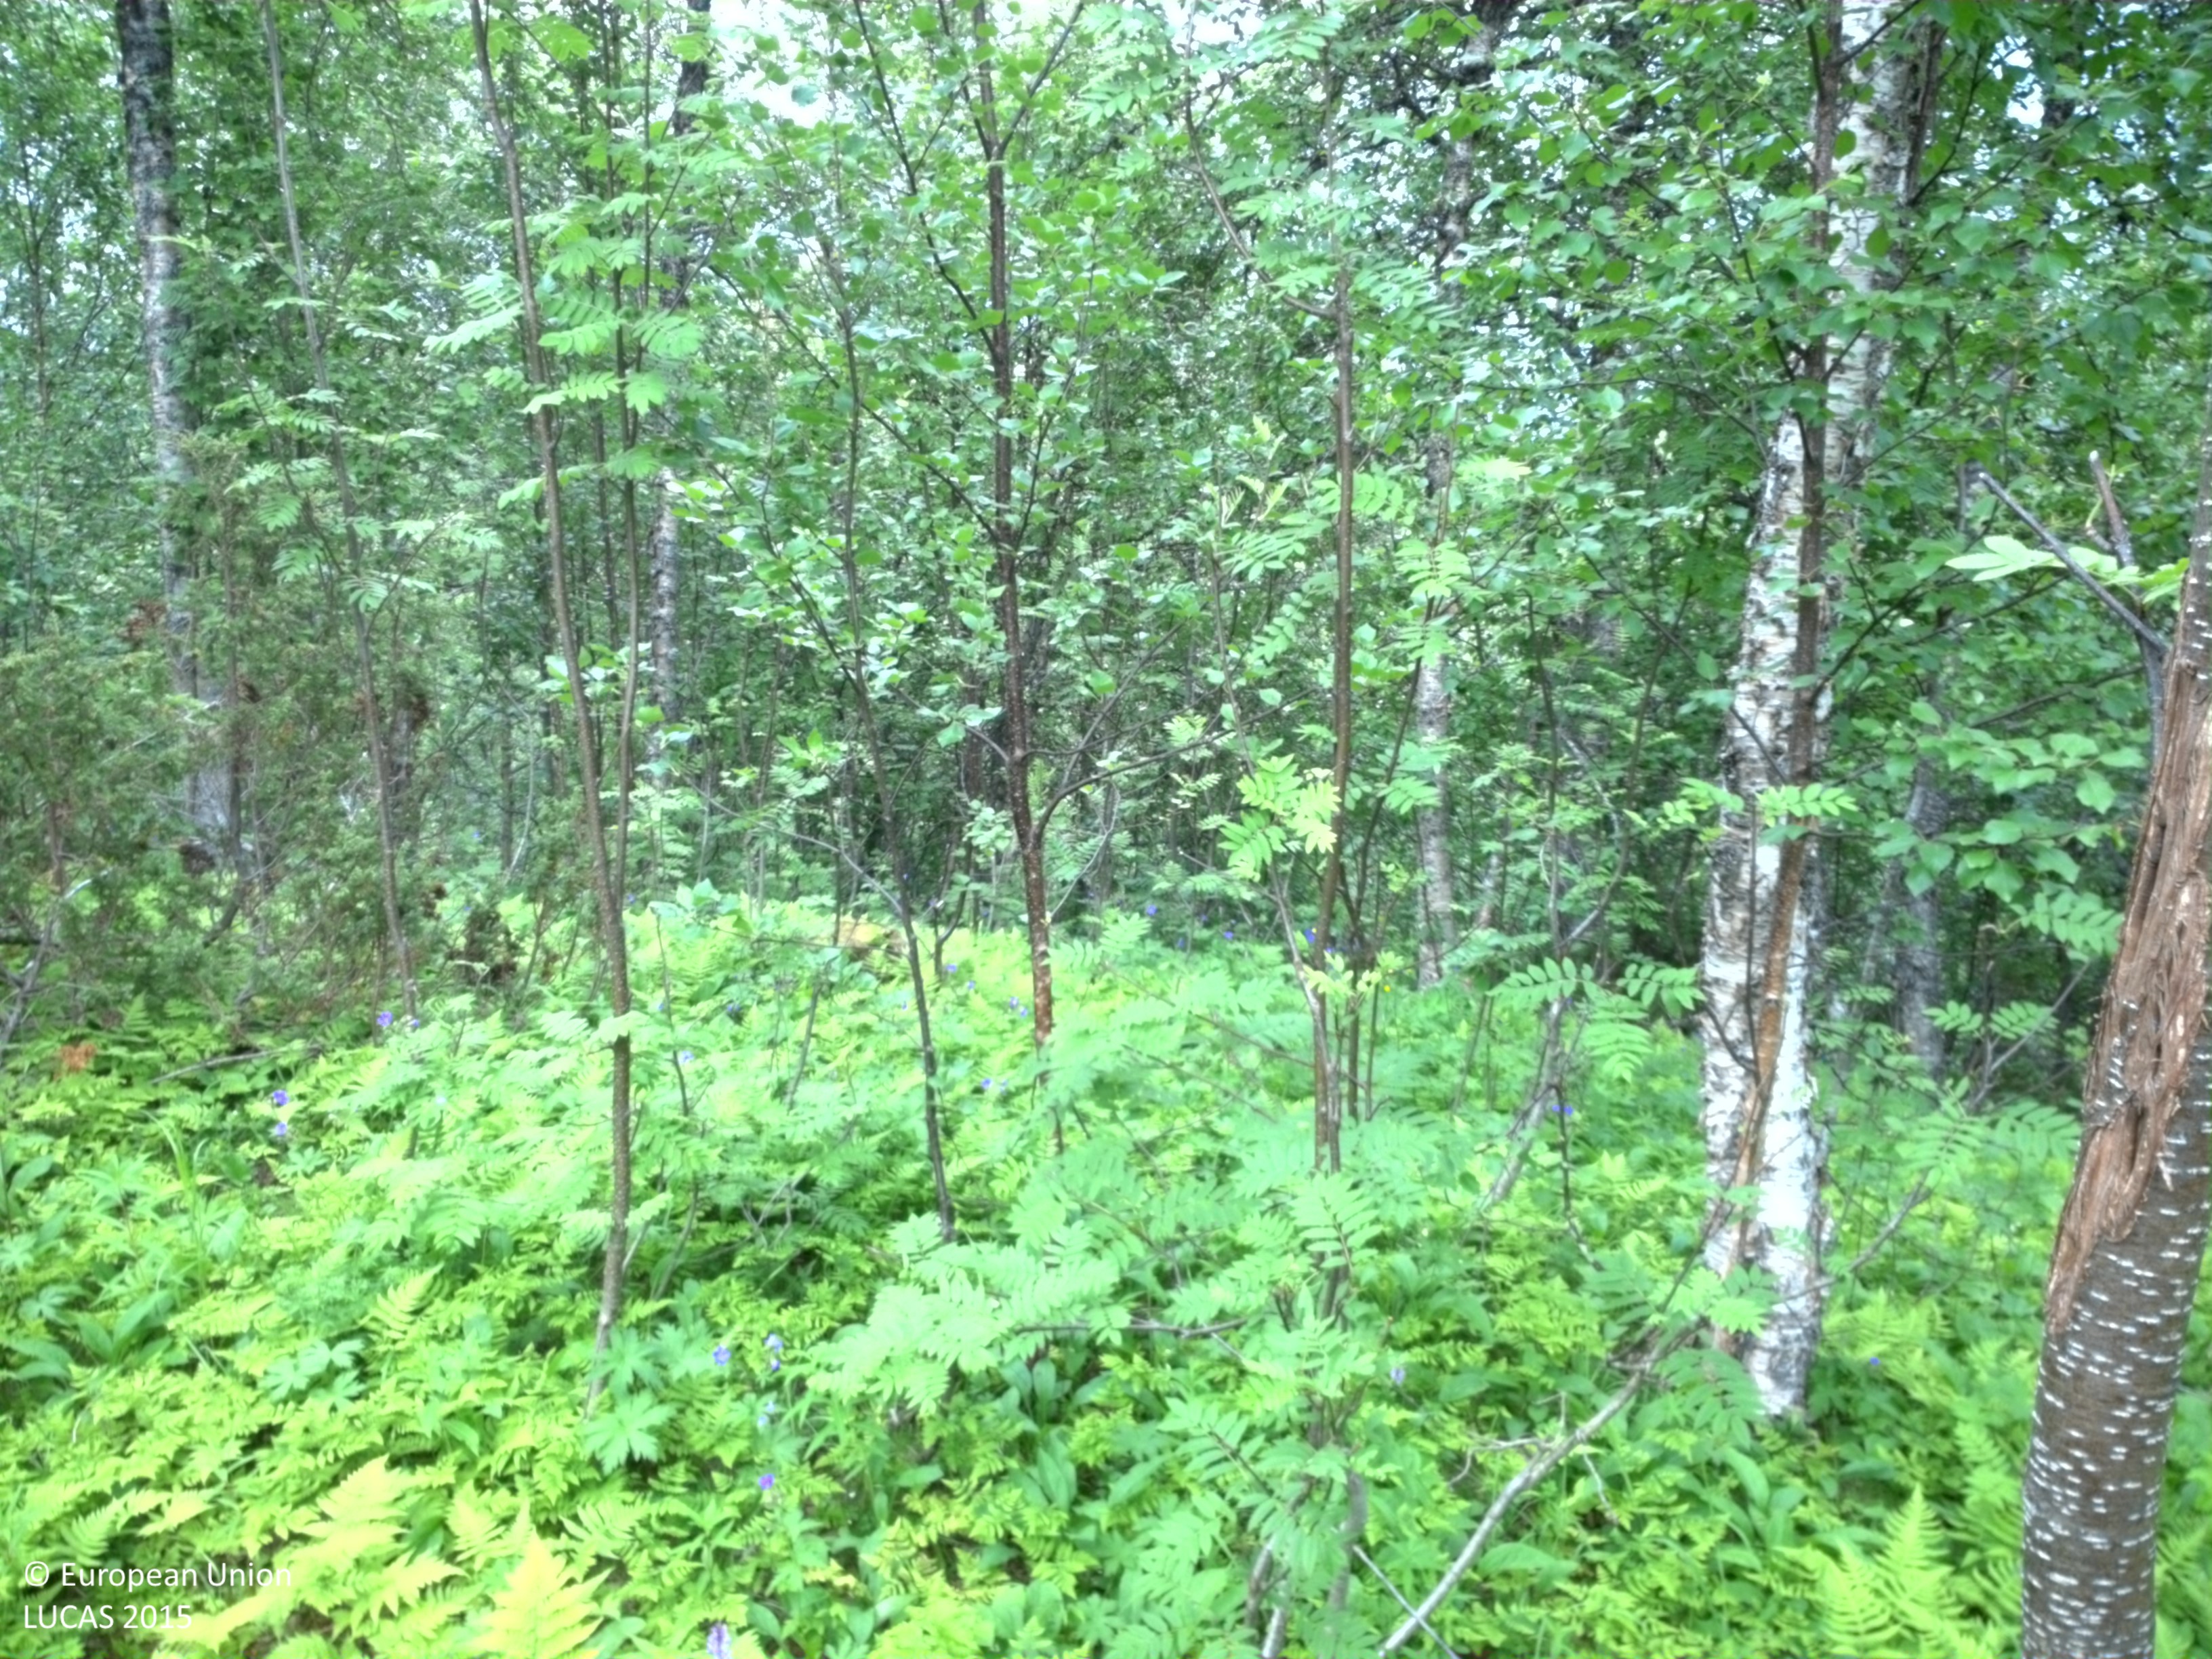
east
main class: Woodland
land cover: Broadleaved woodland
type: non-riverine alder, birch or aspen forest
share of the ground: 25 - 50 %
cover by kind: herbaceous plants 60 %, broadleaved forest trees 35 %, shrubs 5 %
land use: Amenities, museums, leisure
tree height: > 5 m
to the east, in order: Broadleaved woodland; Inland fresh running water; Broadleaved woodland
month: July
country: SE
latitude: 65.6718
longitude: 15.7277
